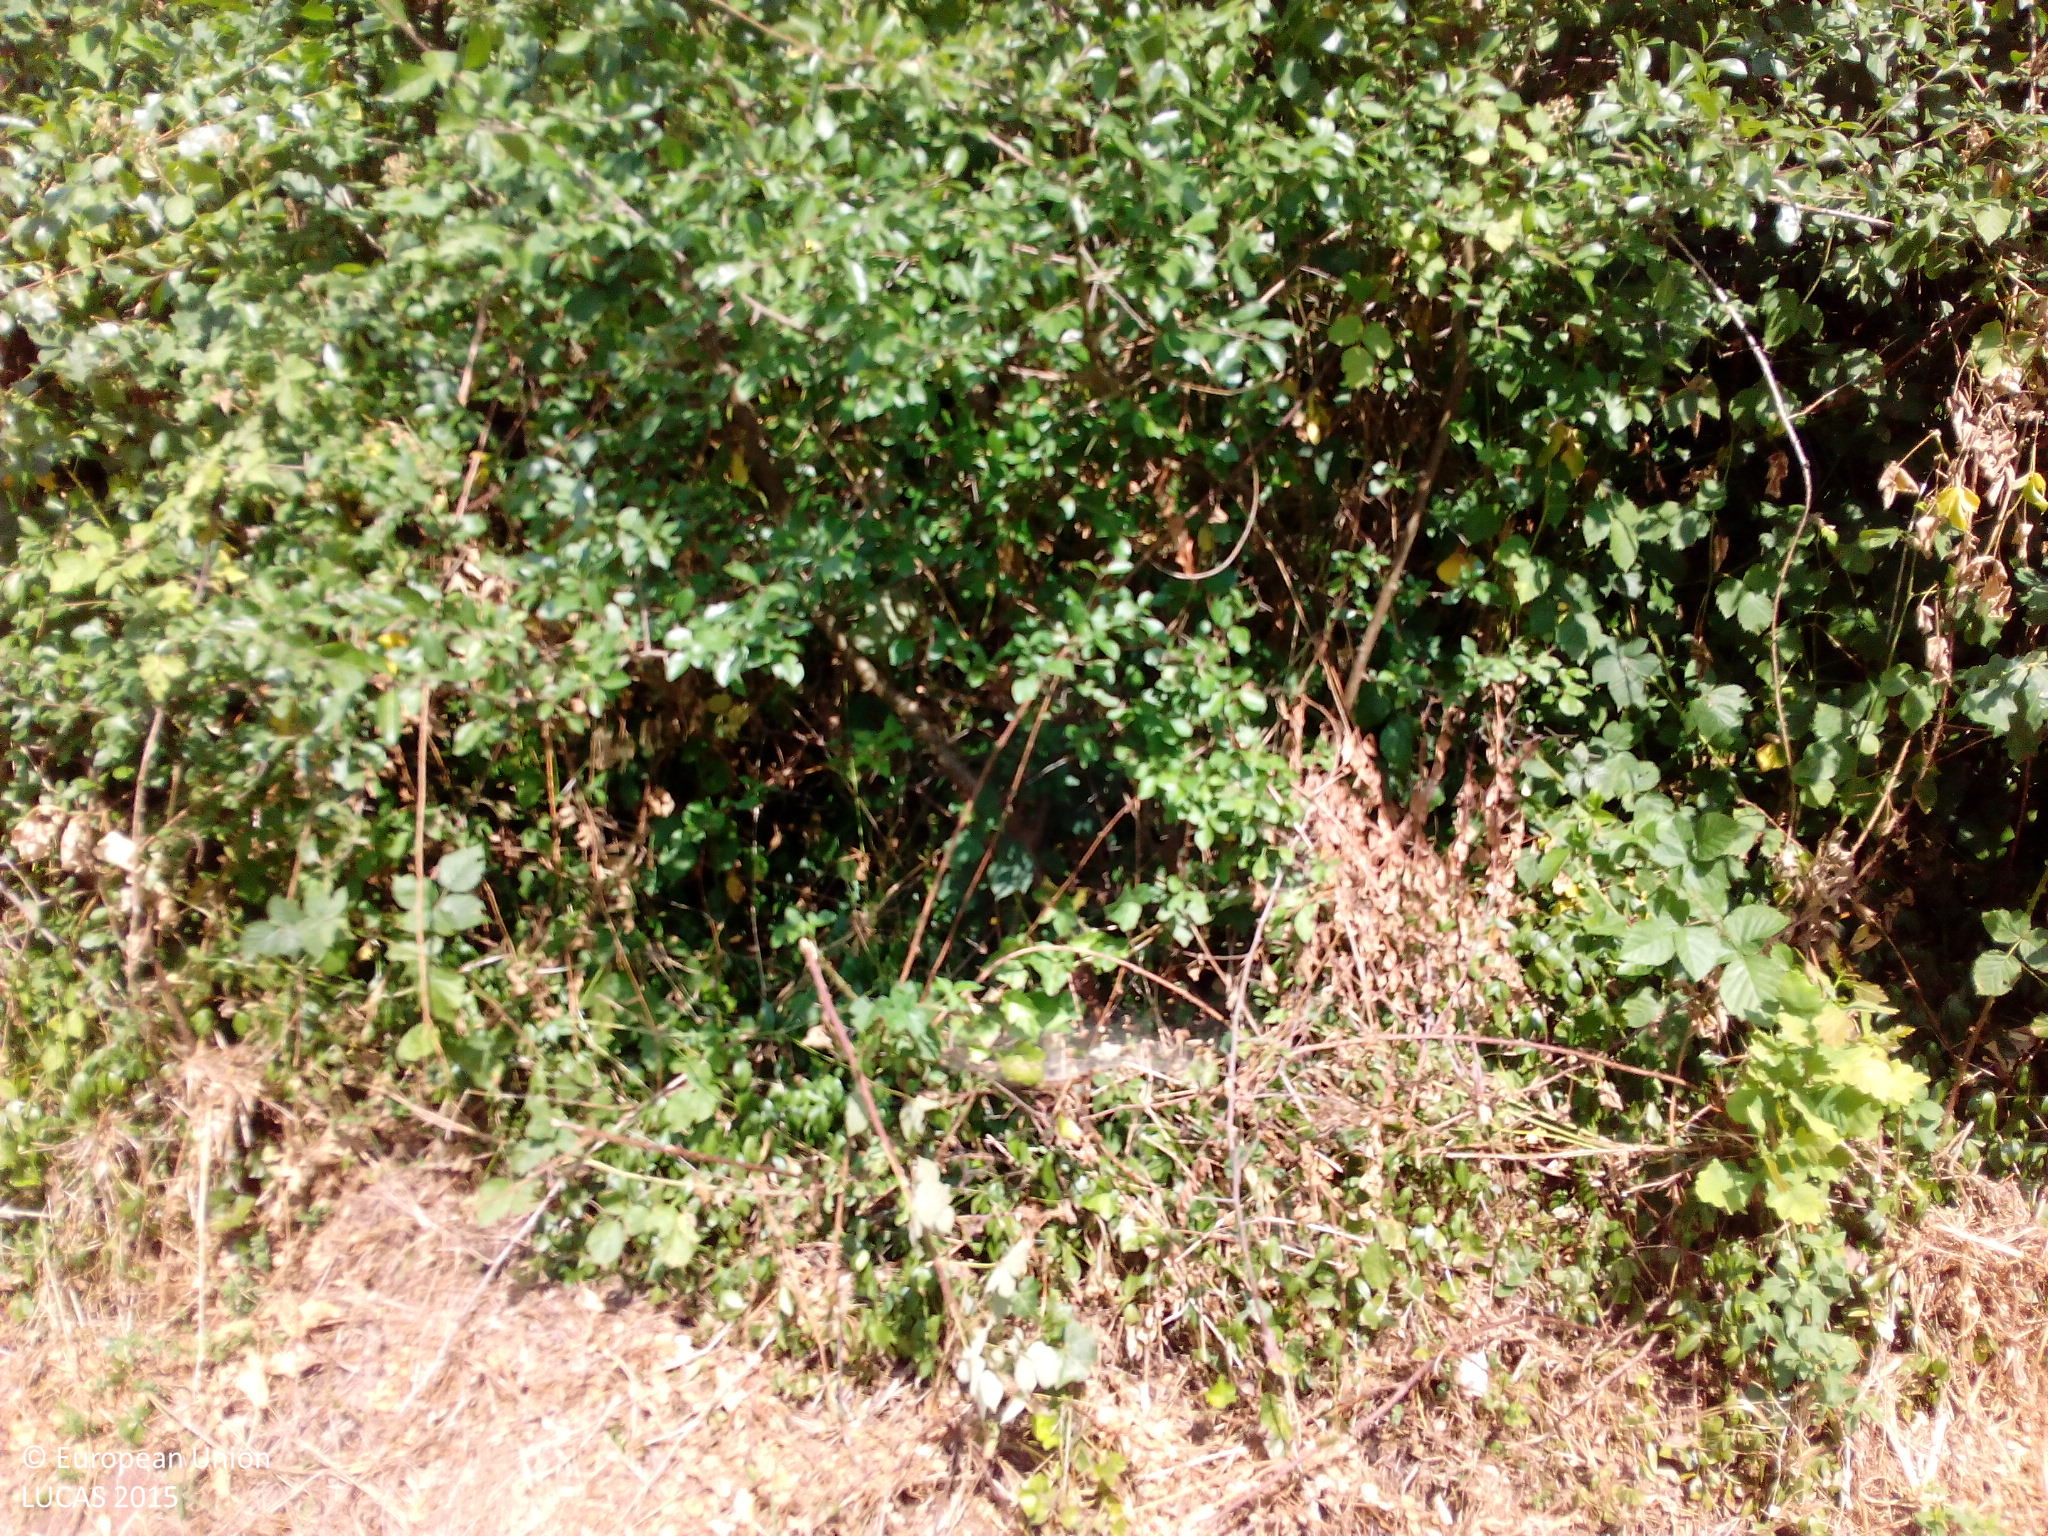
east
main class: Cropland
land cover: Cherry fruit
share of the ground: > 75 %
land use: Kitchen garden
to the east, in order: Cherry fruit; Grassland without tree/shrub cover; Artificial constructions in urban areas; Grassland without tree/shrub cover
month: July
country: DE
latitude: 49.5366
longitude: 7.1399
